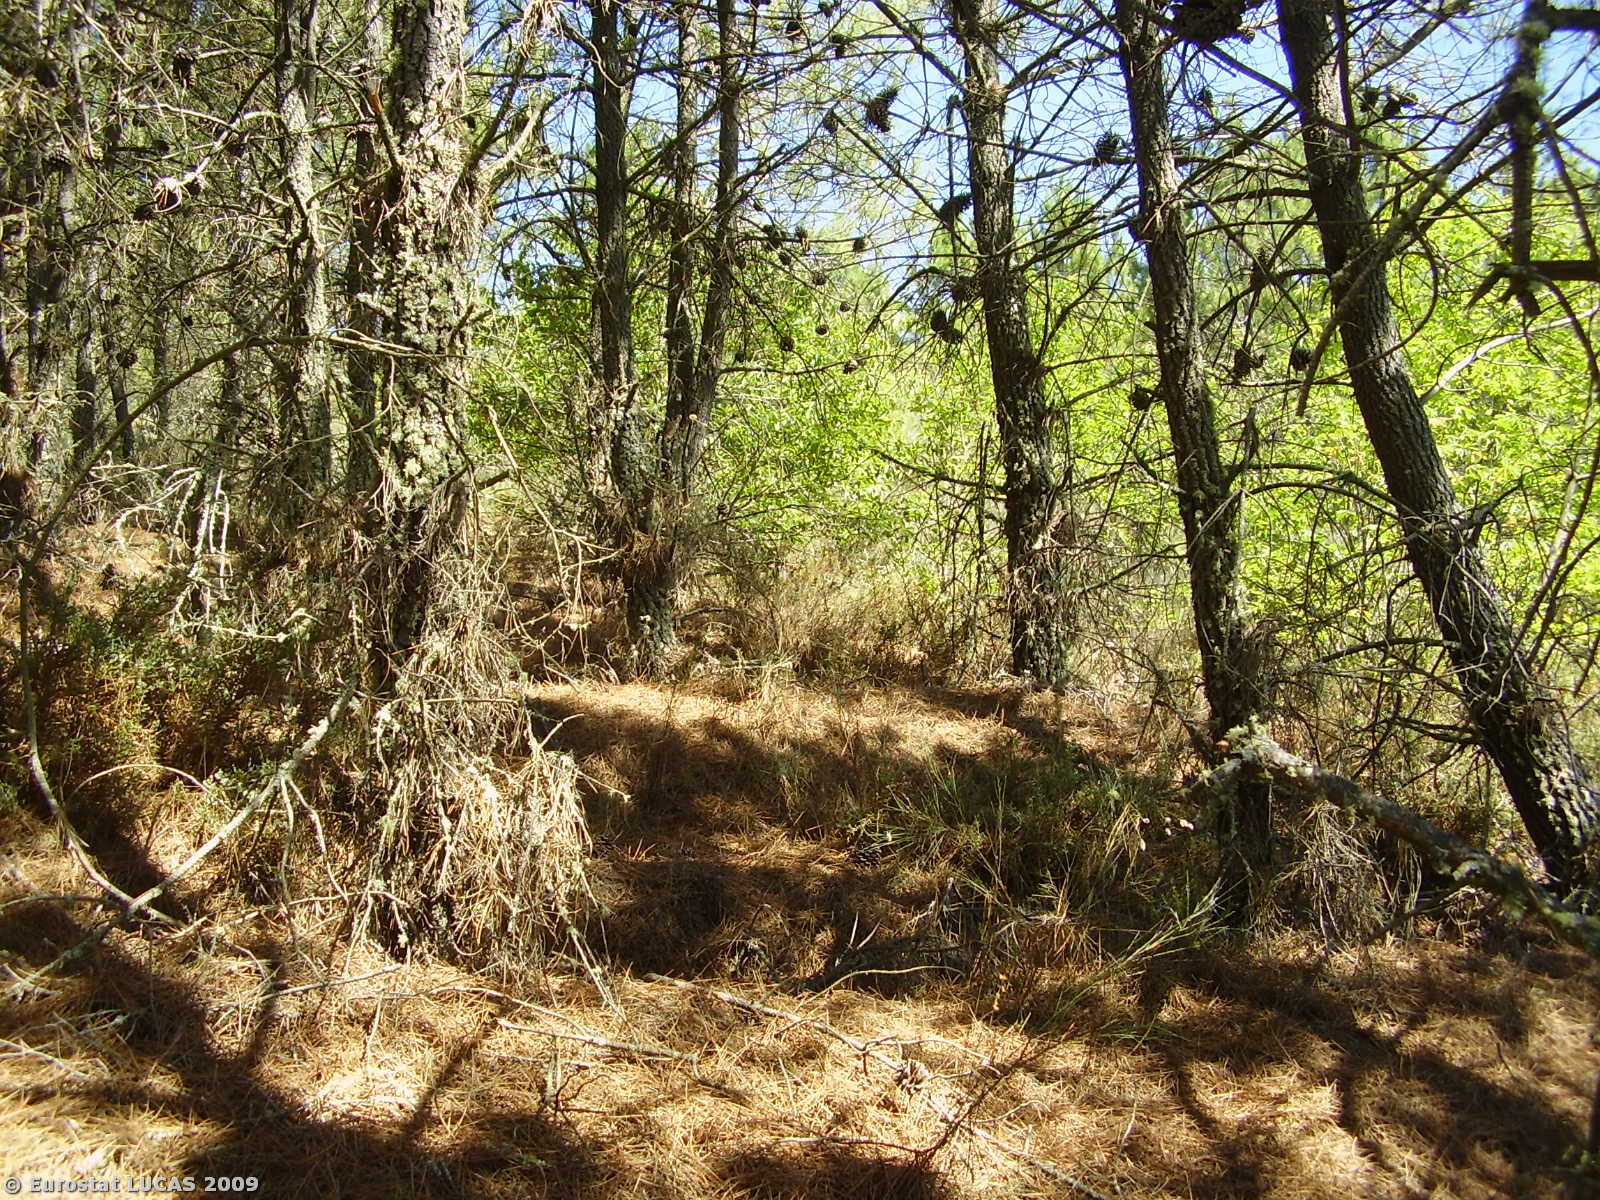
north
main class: Woodland
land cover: Coniferous woodland
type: coniferous forest of the mediterranean region
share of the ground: 10 - 25 %
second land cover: Bare land
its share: > 75 %
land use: Forestry
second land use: Fallow land
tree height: > 5 m
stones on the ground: > 50 %
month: August
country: PT
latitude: 41.2081
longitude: -6.7652
